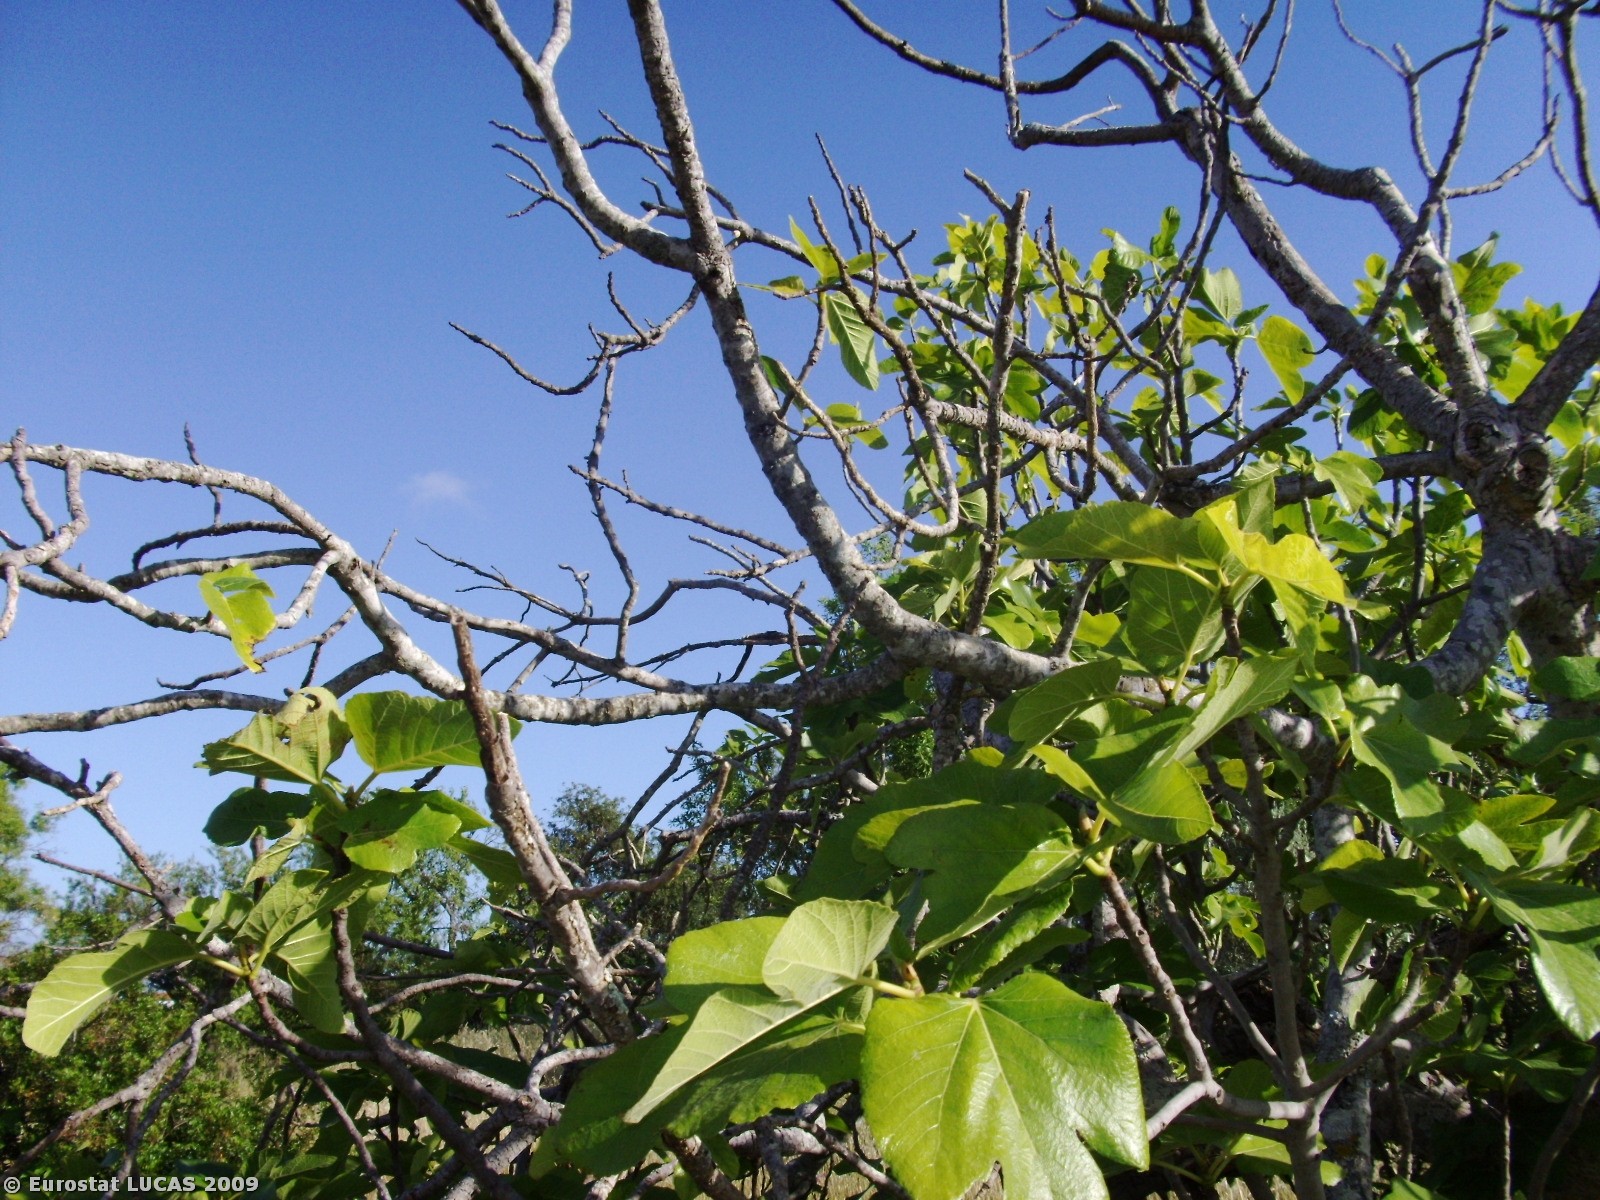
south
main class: Cropland
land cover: Nuts trees
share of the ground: 10 - 25 %
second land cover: Spontaneously vegetated surfaces
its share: 50 - 75 %
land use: Agriculture (excluding fallow land and kitchen gardens)
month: May
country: PT
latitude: 37.1206
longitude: -8.2164
